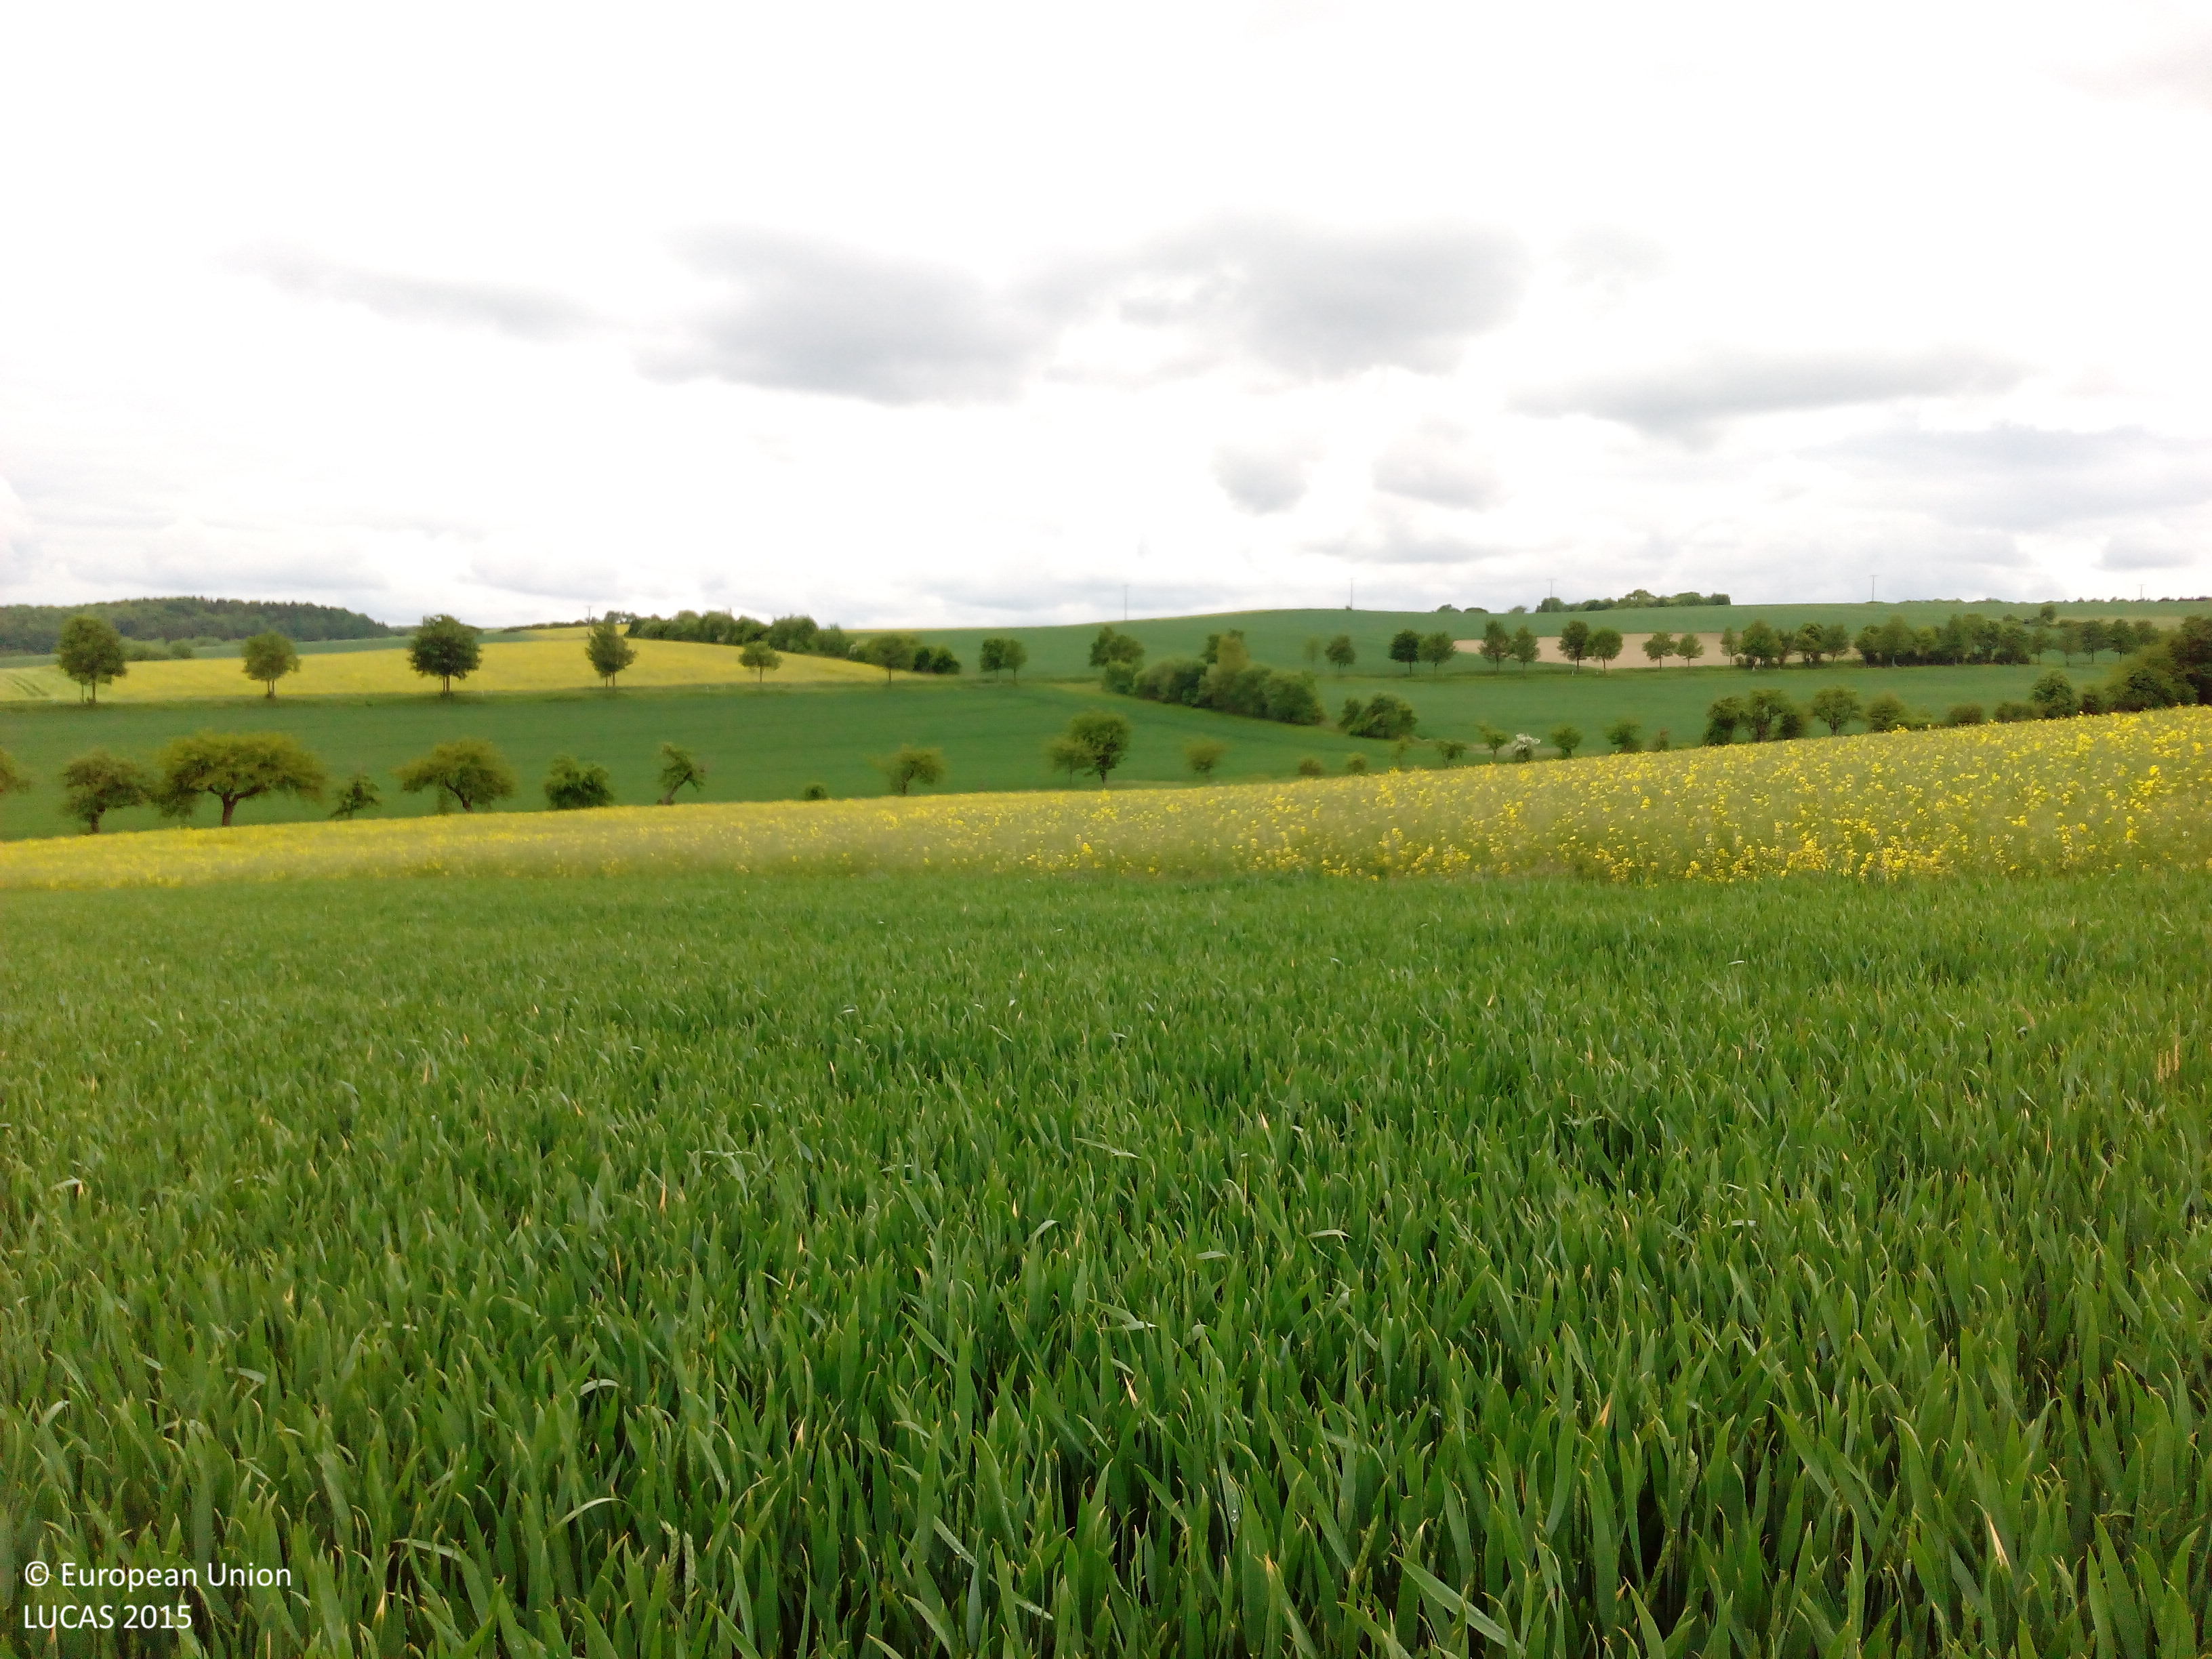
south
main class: Cropland
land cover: Rape and turnip rape
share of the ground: > 75 %
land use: Agriculture (excluding fallow land and kitchen gardens)
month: May
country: DE
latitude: 52.0000
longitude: 9.9272
